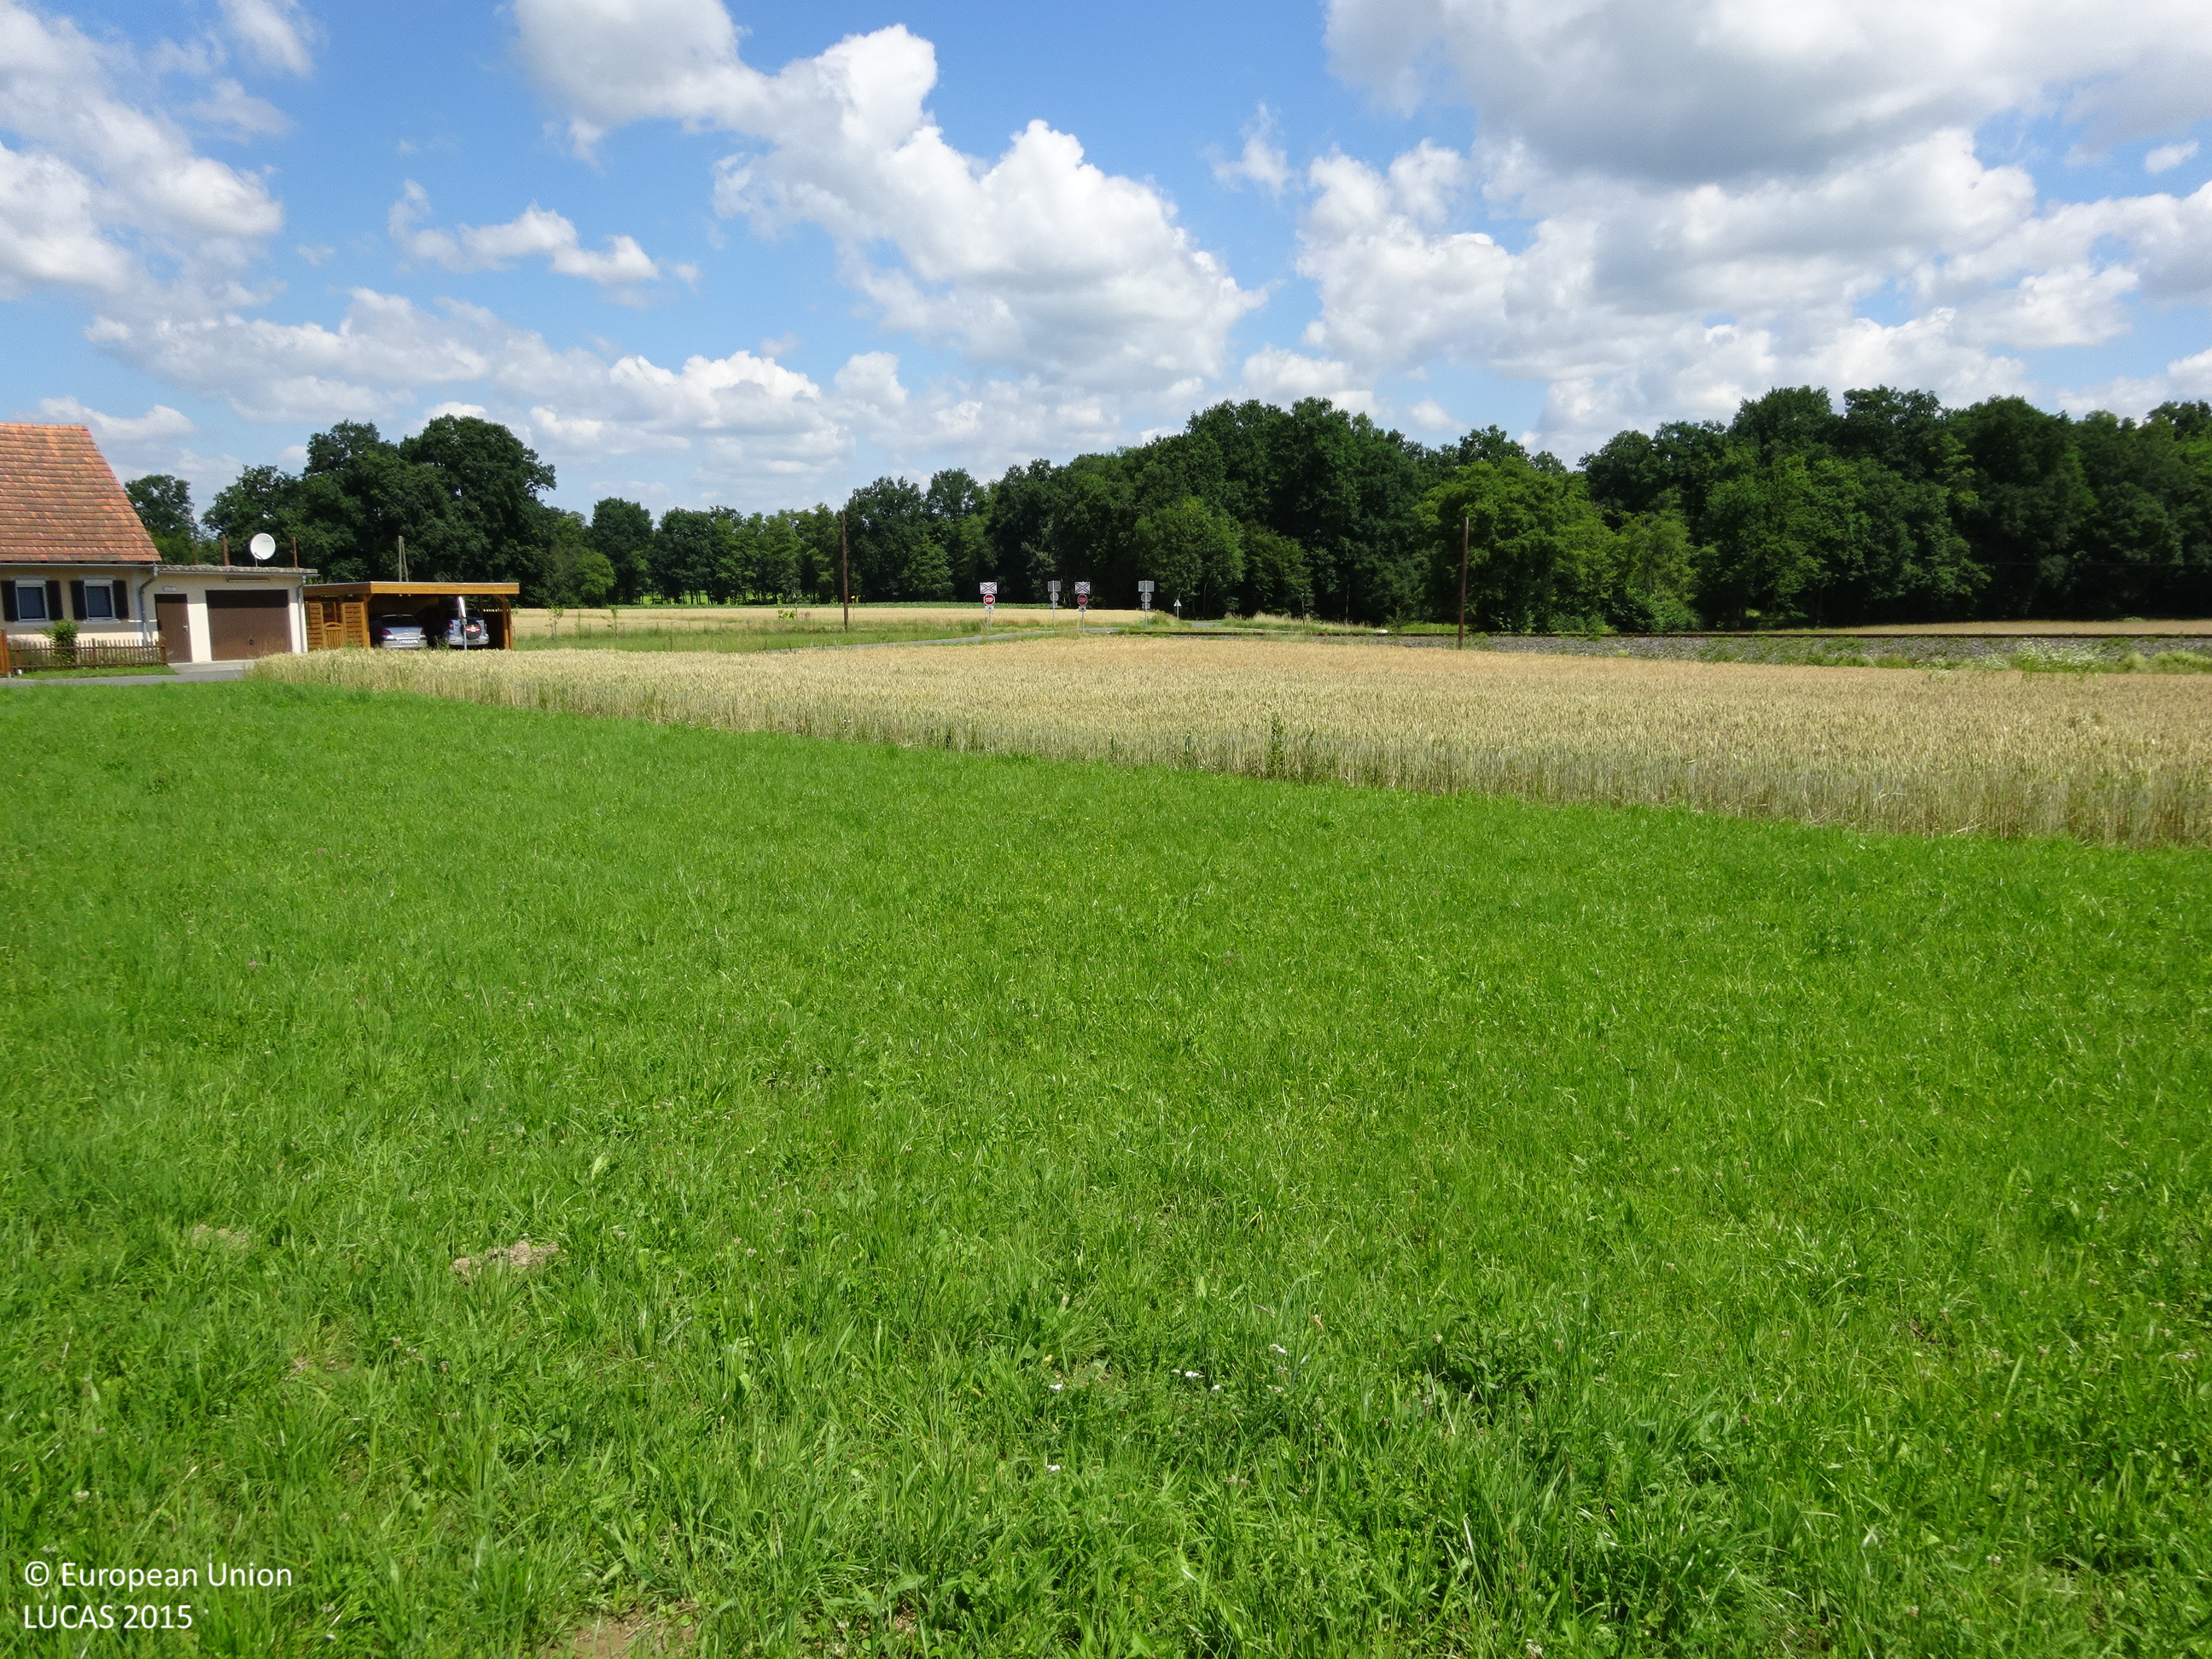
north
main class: Grassland
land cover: Grassland without tree/shrub cover
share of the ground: > 75 %
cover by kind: herbaceous plants 100 %
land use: Agriculture (excluding fallow land and kitchen gardens)
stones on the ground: < 10 %
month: June
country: AT
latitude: 46.7285
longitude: 15.9277
